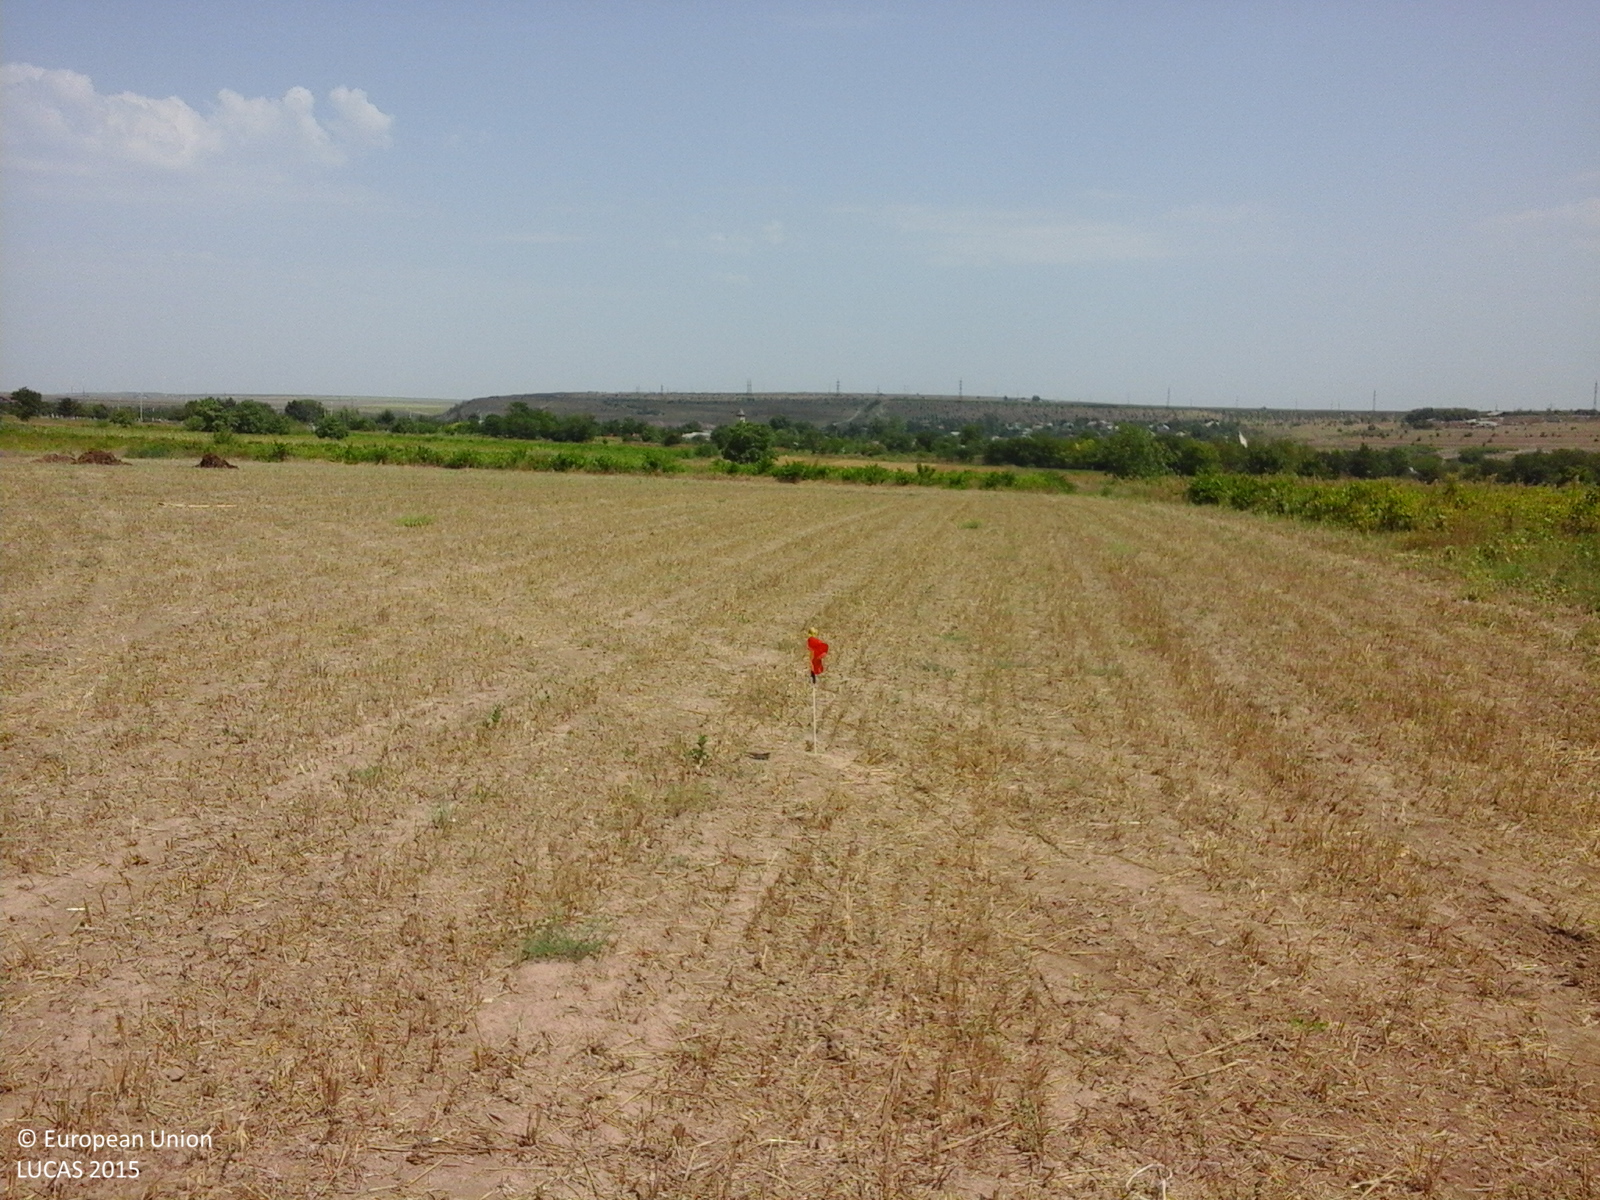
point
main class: Cropland
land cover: Oats
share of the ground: 25 - 50 %
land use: Agriculture (excluding fallow land and kitchen gardens)
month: August
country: RO
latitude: 44.2804
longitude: 28.1661
